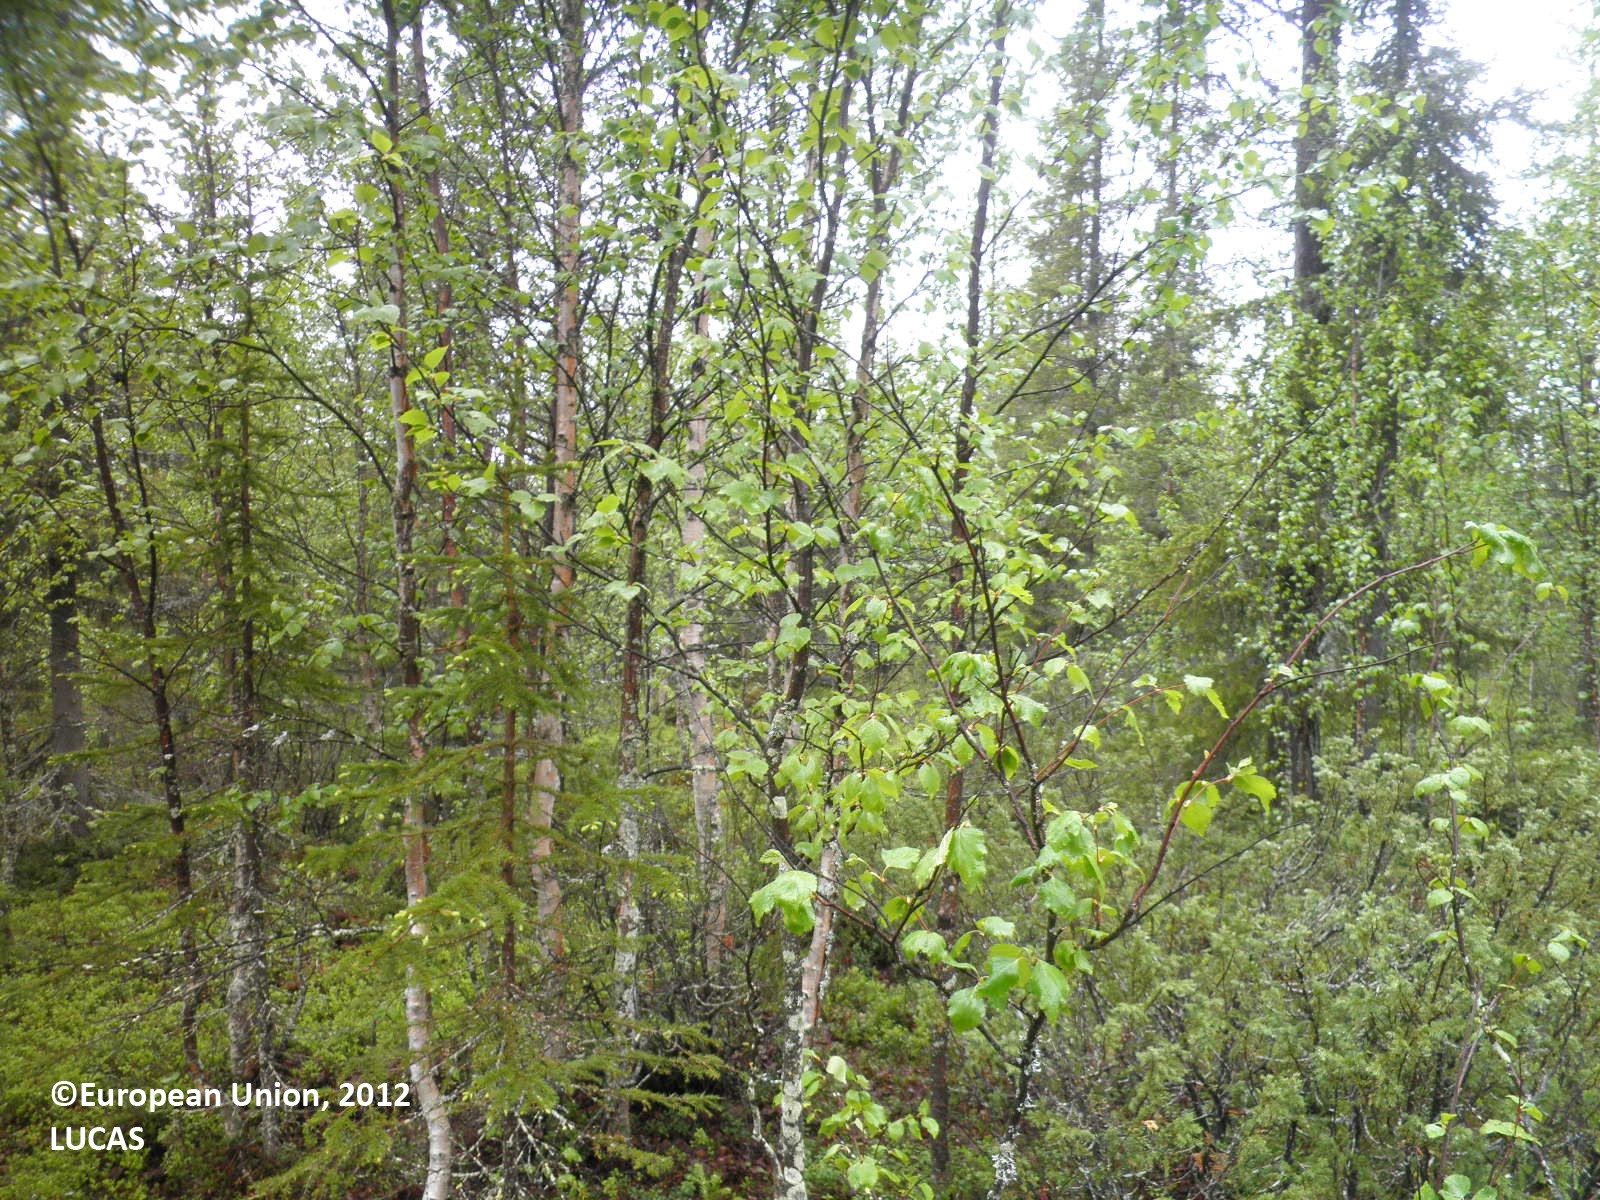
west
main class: Woodland
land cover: Pine dominated mixed woodland
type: boreal forest
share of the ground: > 75 %
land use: Forestry
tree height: > 5 m
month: June
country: FI
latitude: 68.0204
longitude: 25.7274
